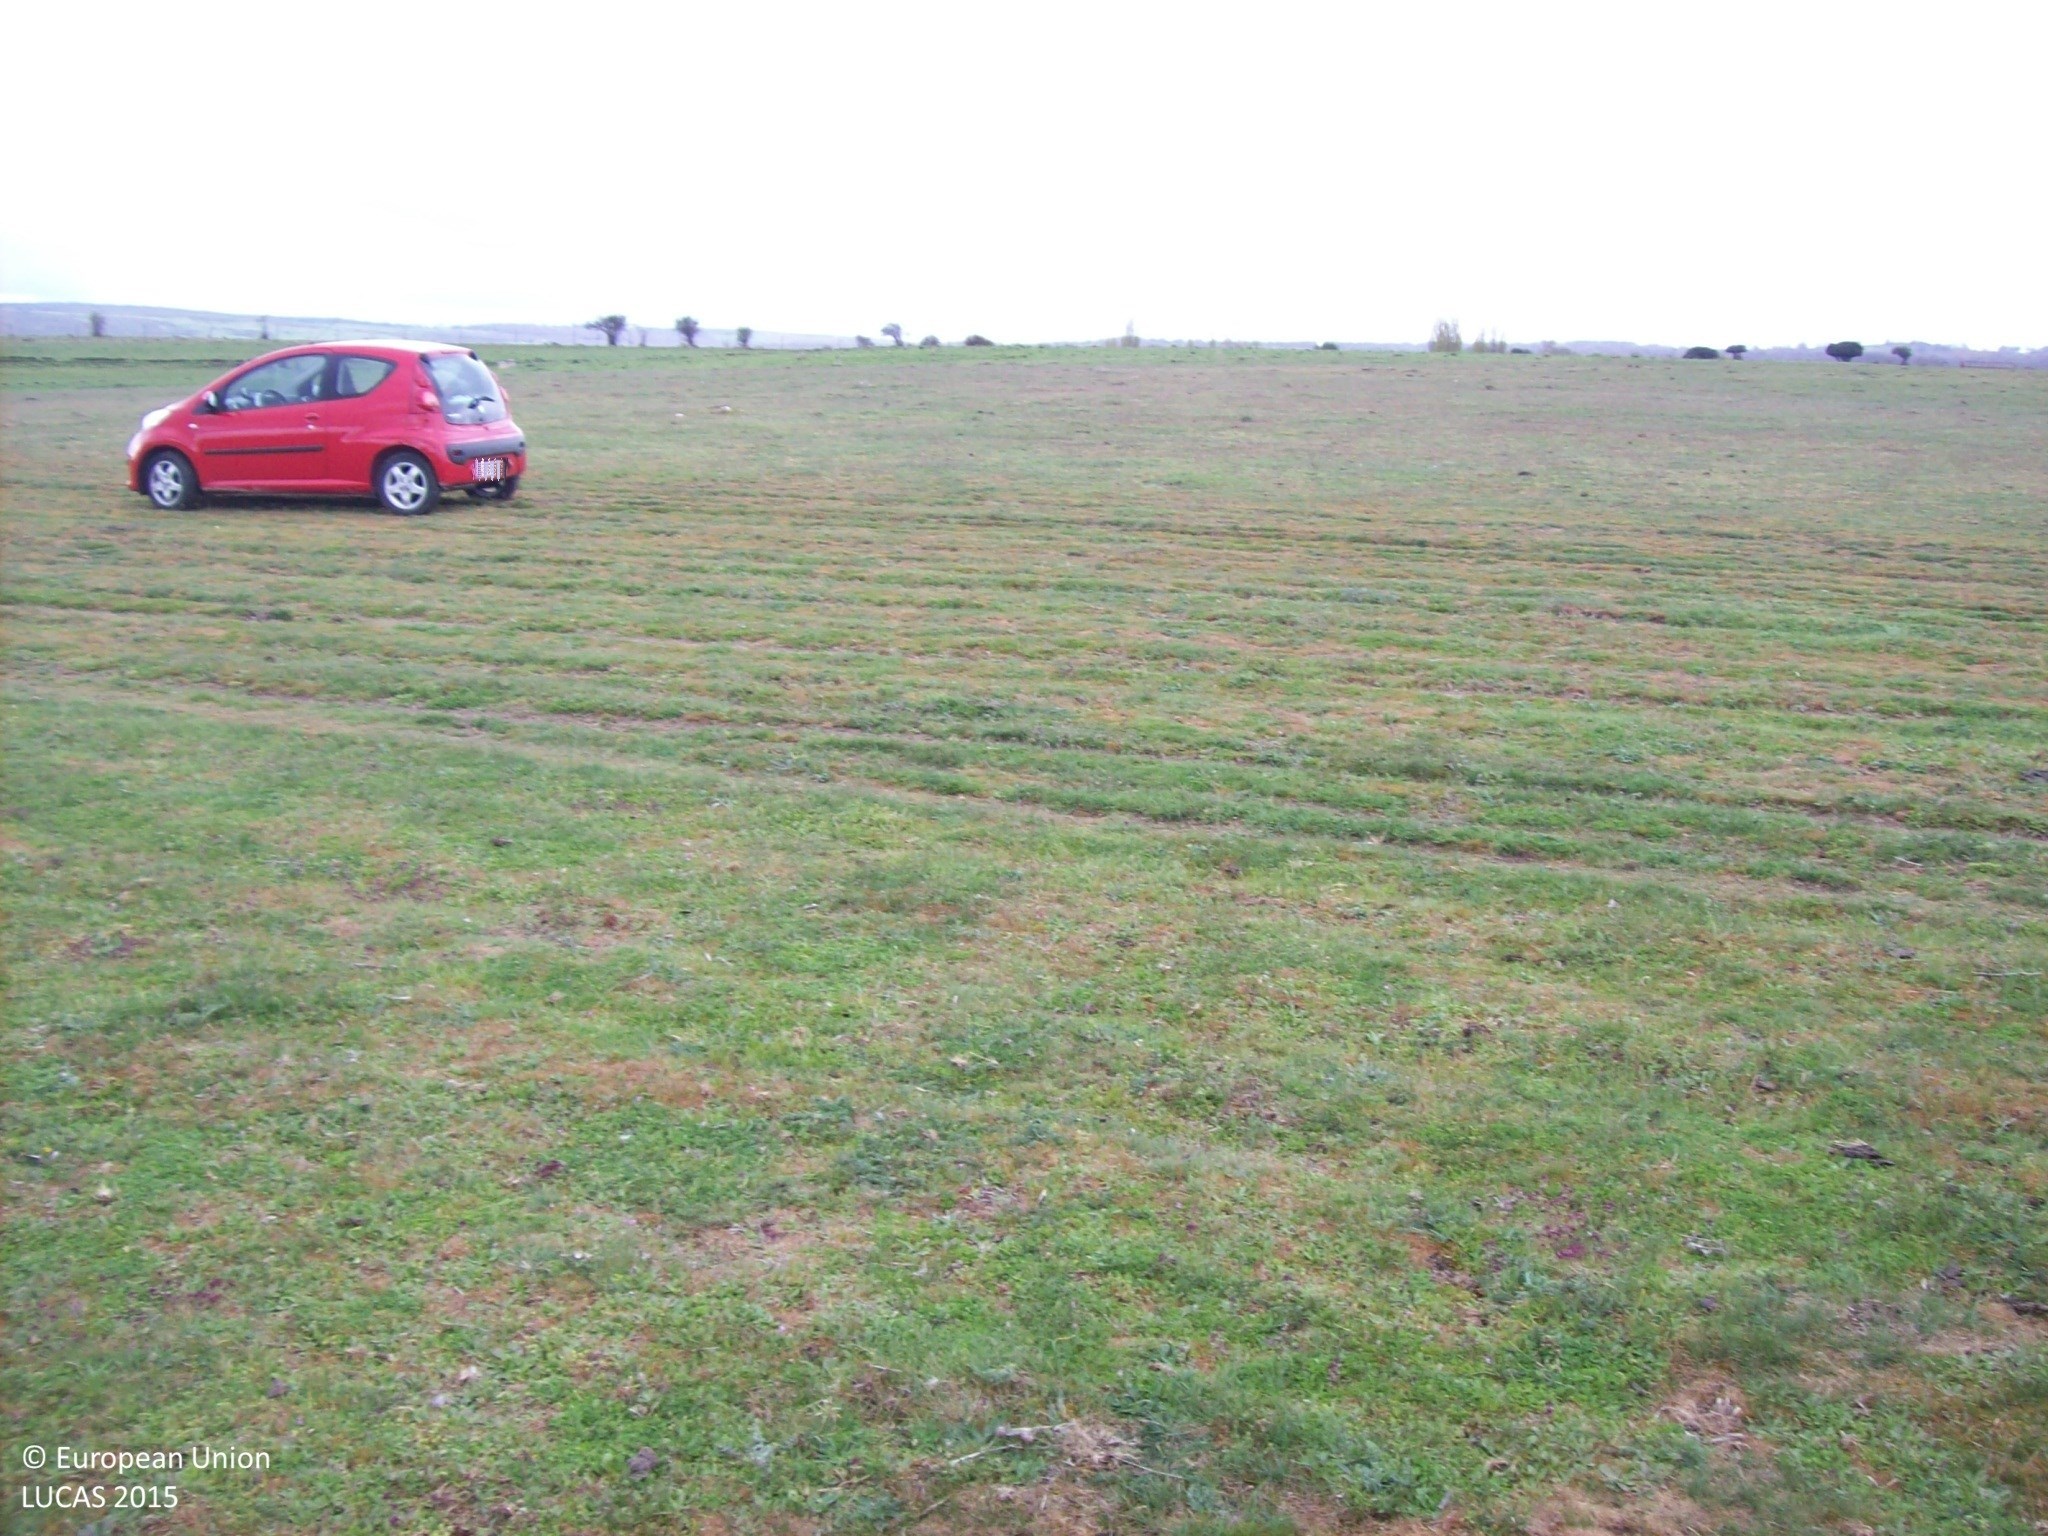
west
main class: Grassland
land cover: Grassland without tree/shrub cover
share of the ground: > 75 %
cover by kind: herbaceous plants 95 %
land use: Agriculture (excluding fallow land and kitchen gardens)
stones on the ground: < 10 %
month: April
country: ES
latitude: 40.5884
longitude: -4.4295
